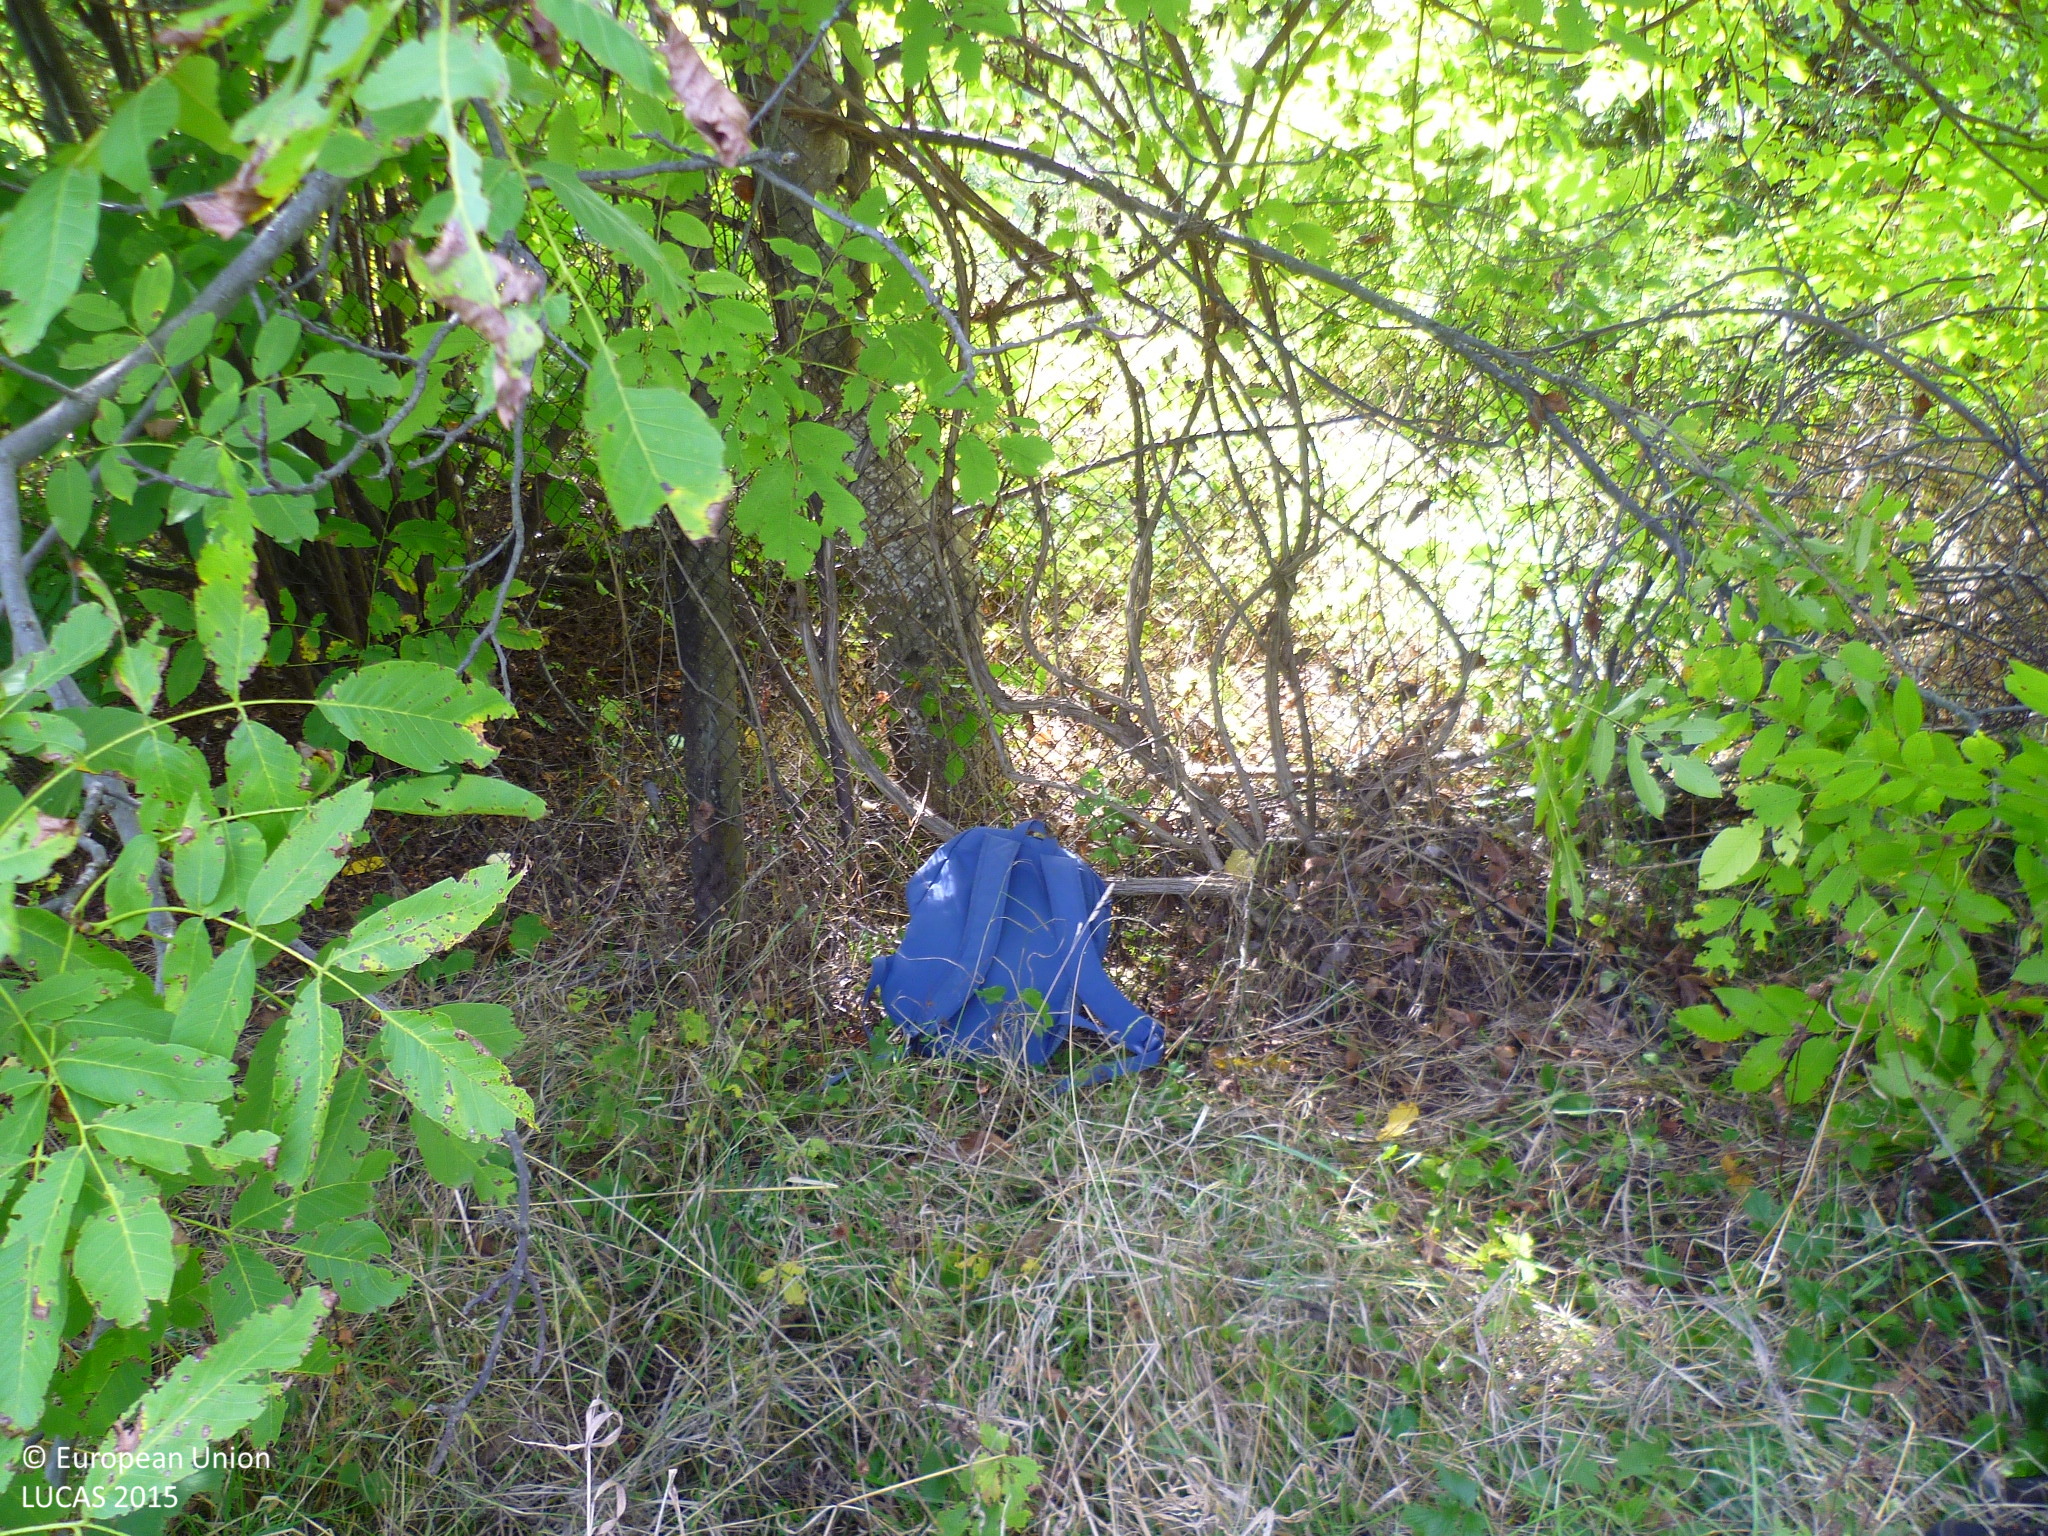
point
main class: Cropland
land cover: Nuts trees
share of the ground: 25 - 50 %
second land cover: Spontaneously vegetated surfaces
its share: 50 - 75 %
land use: Kitchen garden
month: October
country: BG
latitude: 42.8376
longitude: 22.8385
